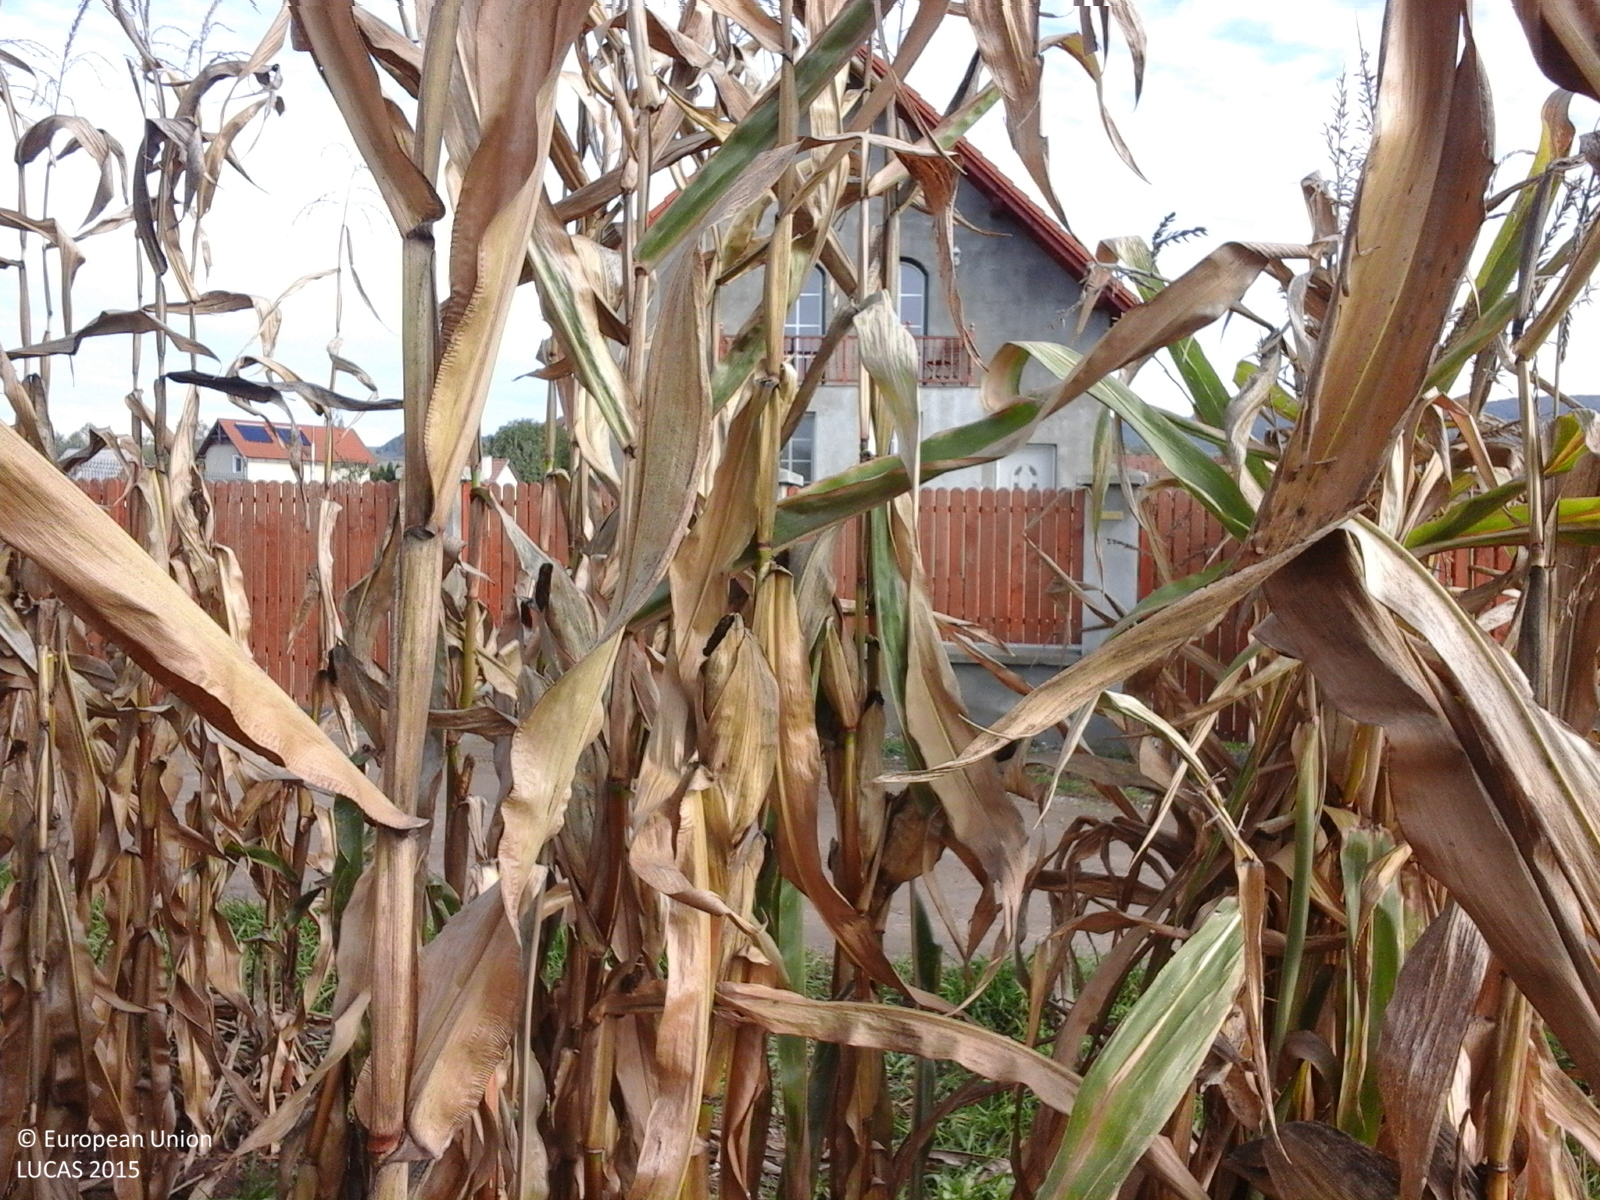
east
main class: Cropland
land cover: Maize
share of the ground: > 75 %
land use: Agriculture (excluding fallow land and kitchen gardens)
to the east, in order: Maize; Artificial constructions in urban areas; Lucerne; Grassland without tree/shrub cover; Artificial constructions in urban areas
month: October
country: RO
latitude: 46.3214
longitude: 25.3118
